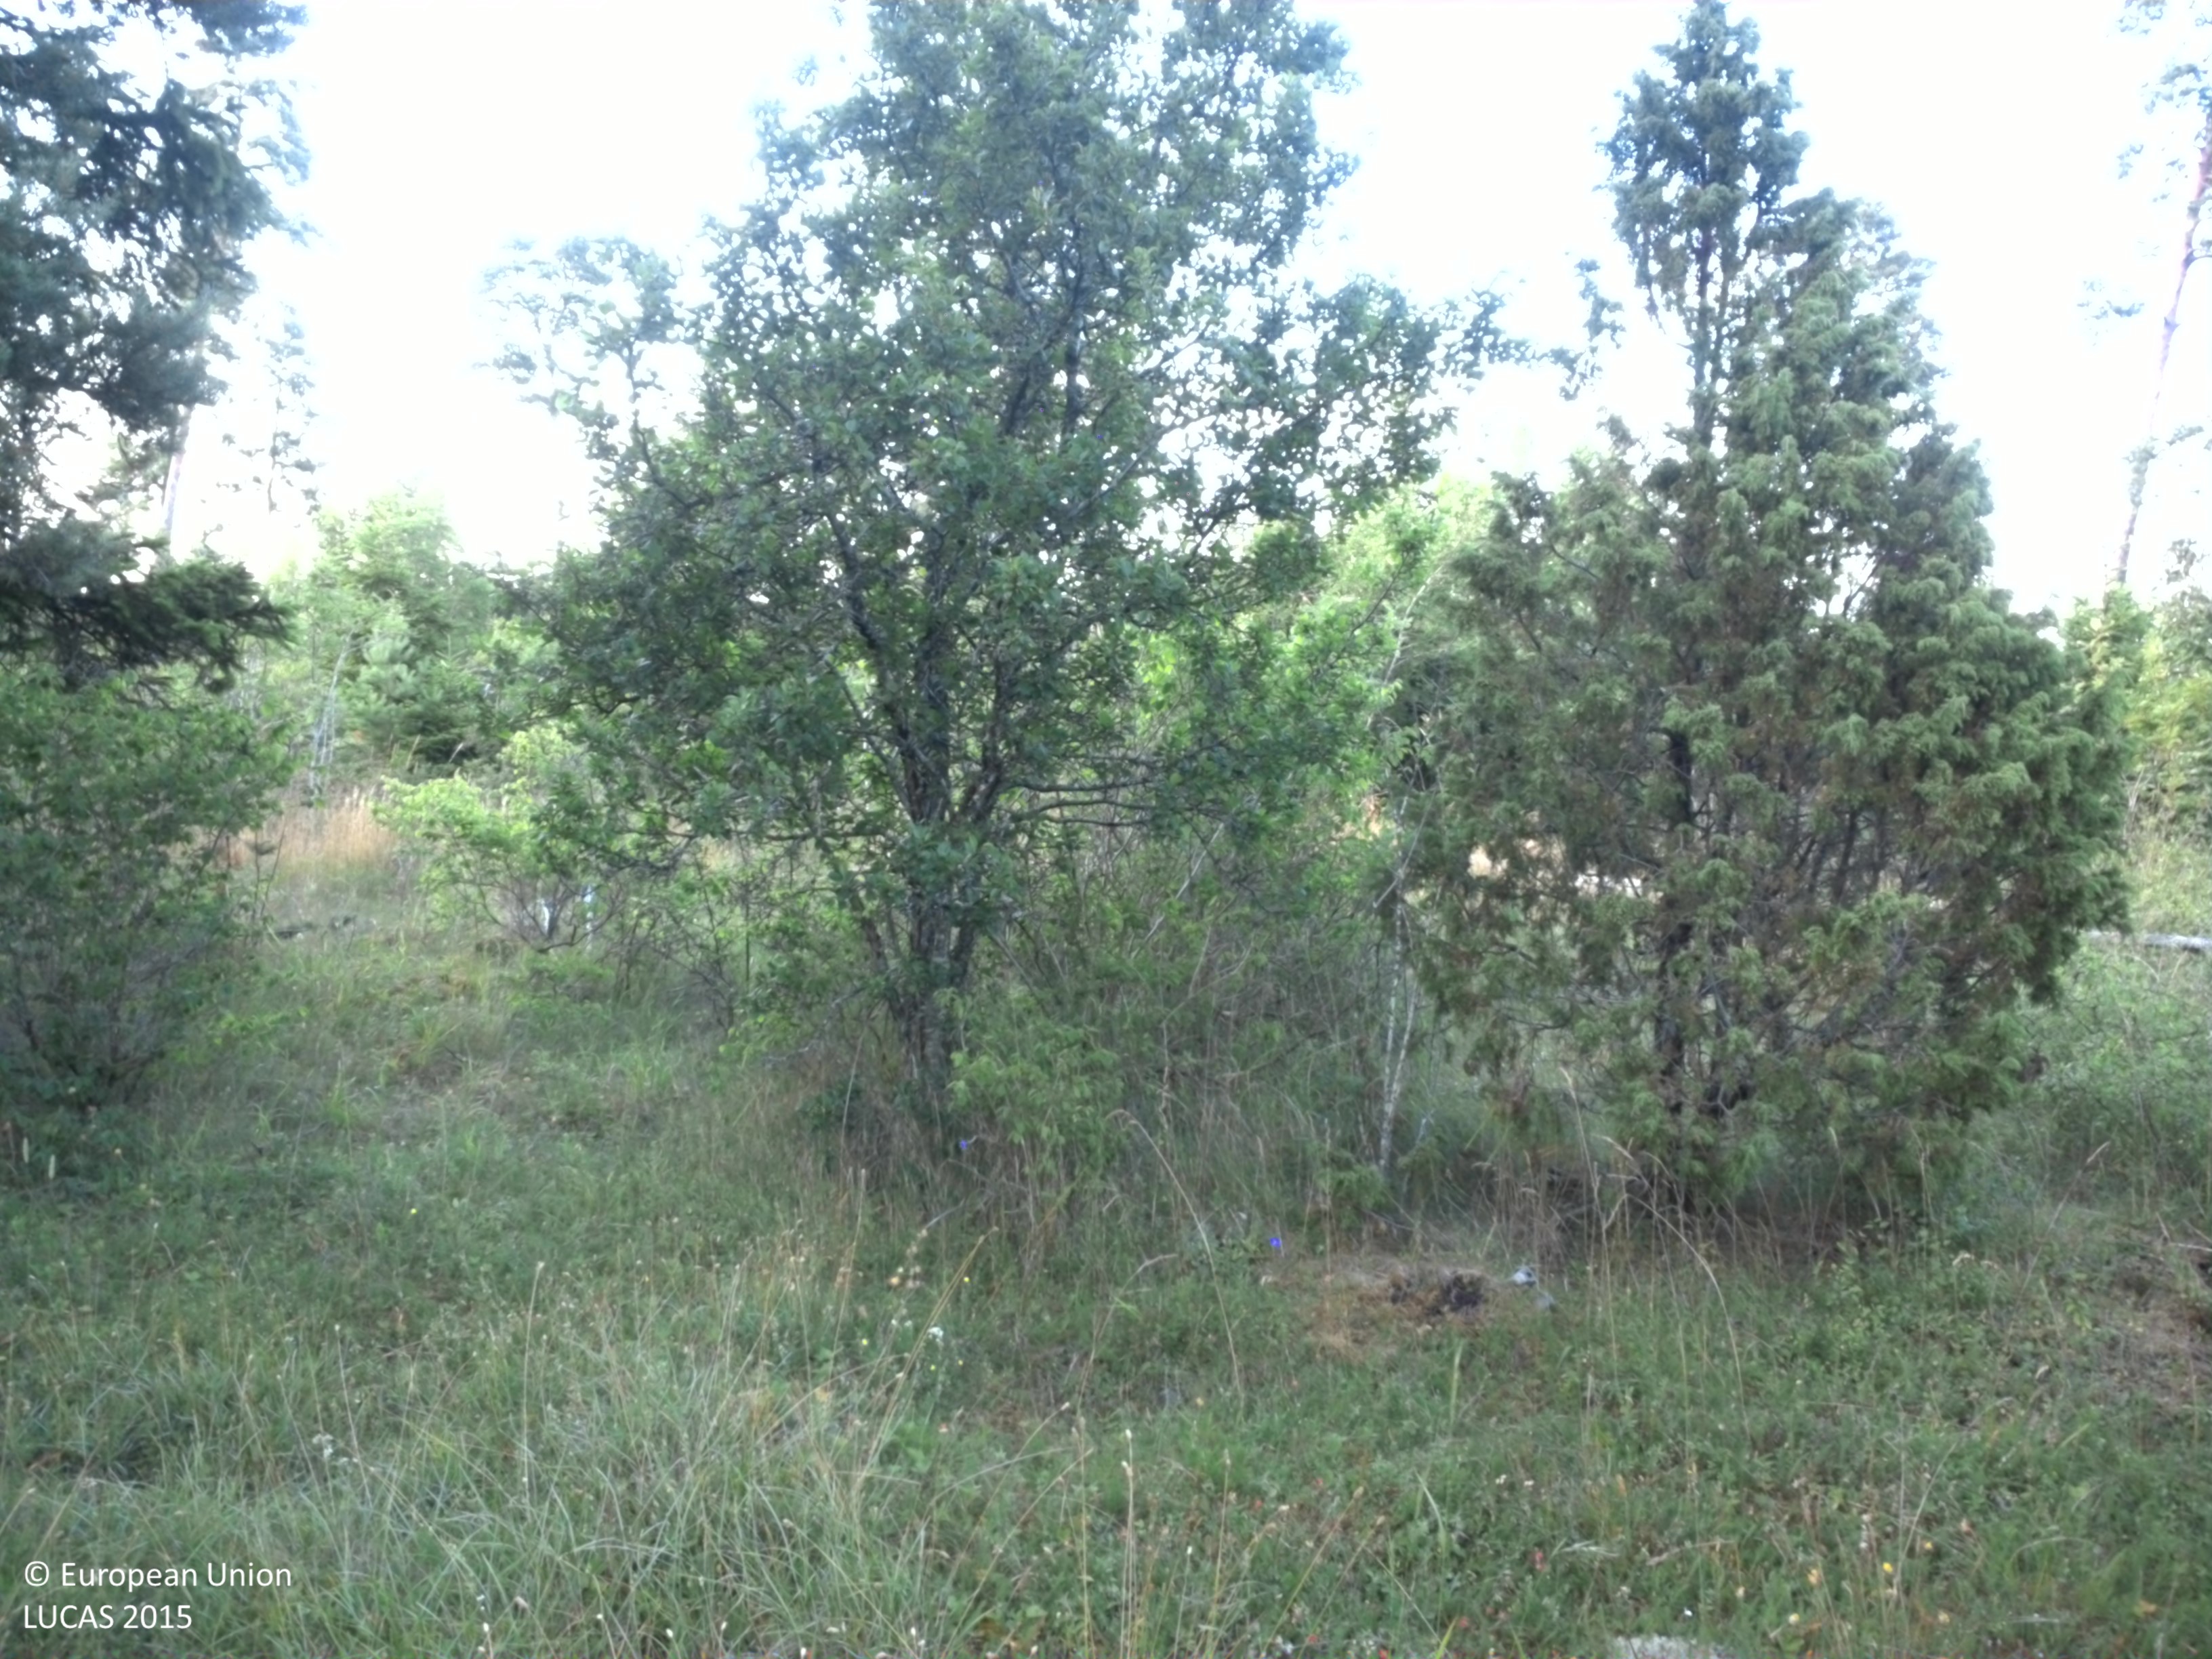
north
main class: Grassland
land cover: Grassland with sparse tree/shrub cover
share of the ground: > 75 %
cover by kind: herbaceous plants 90 %, coniferous forest trees 5 %, shrubs 5 %
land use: Semi-natural and natural areas not in use
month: July
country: SE
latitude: 57.5893
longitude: 18.7589
